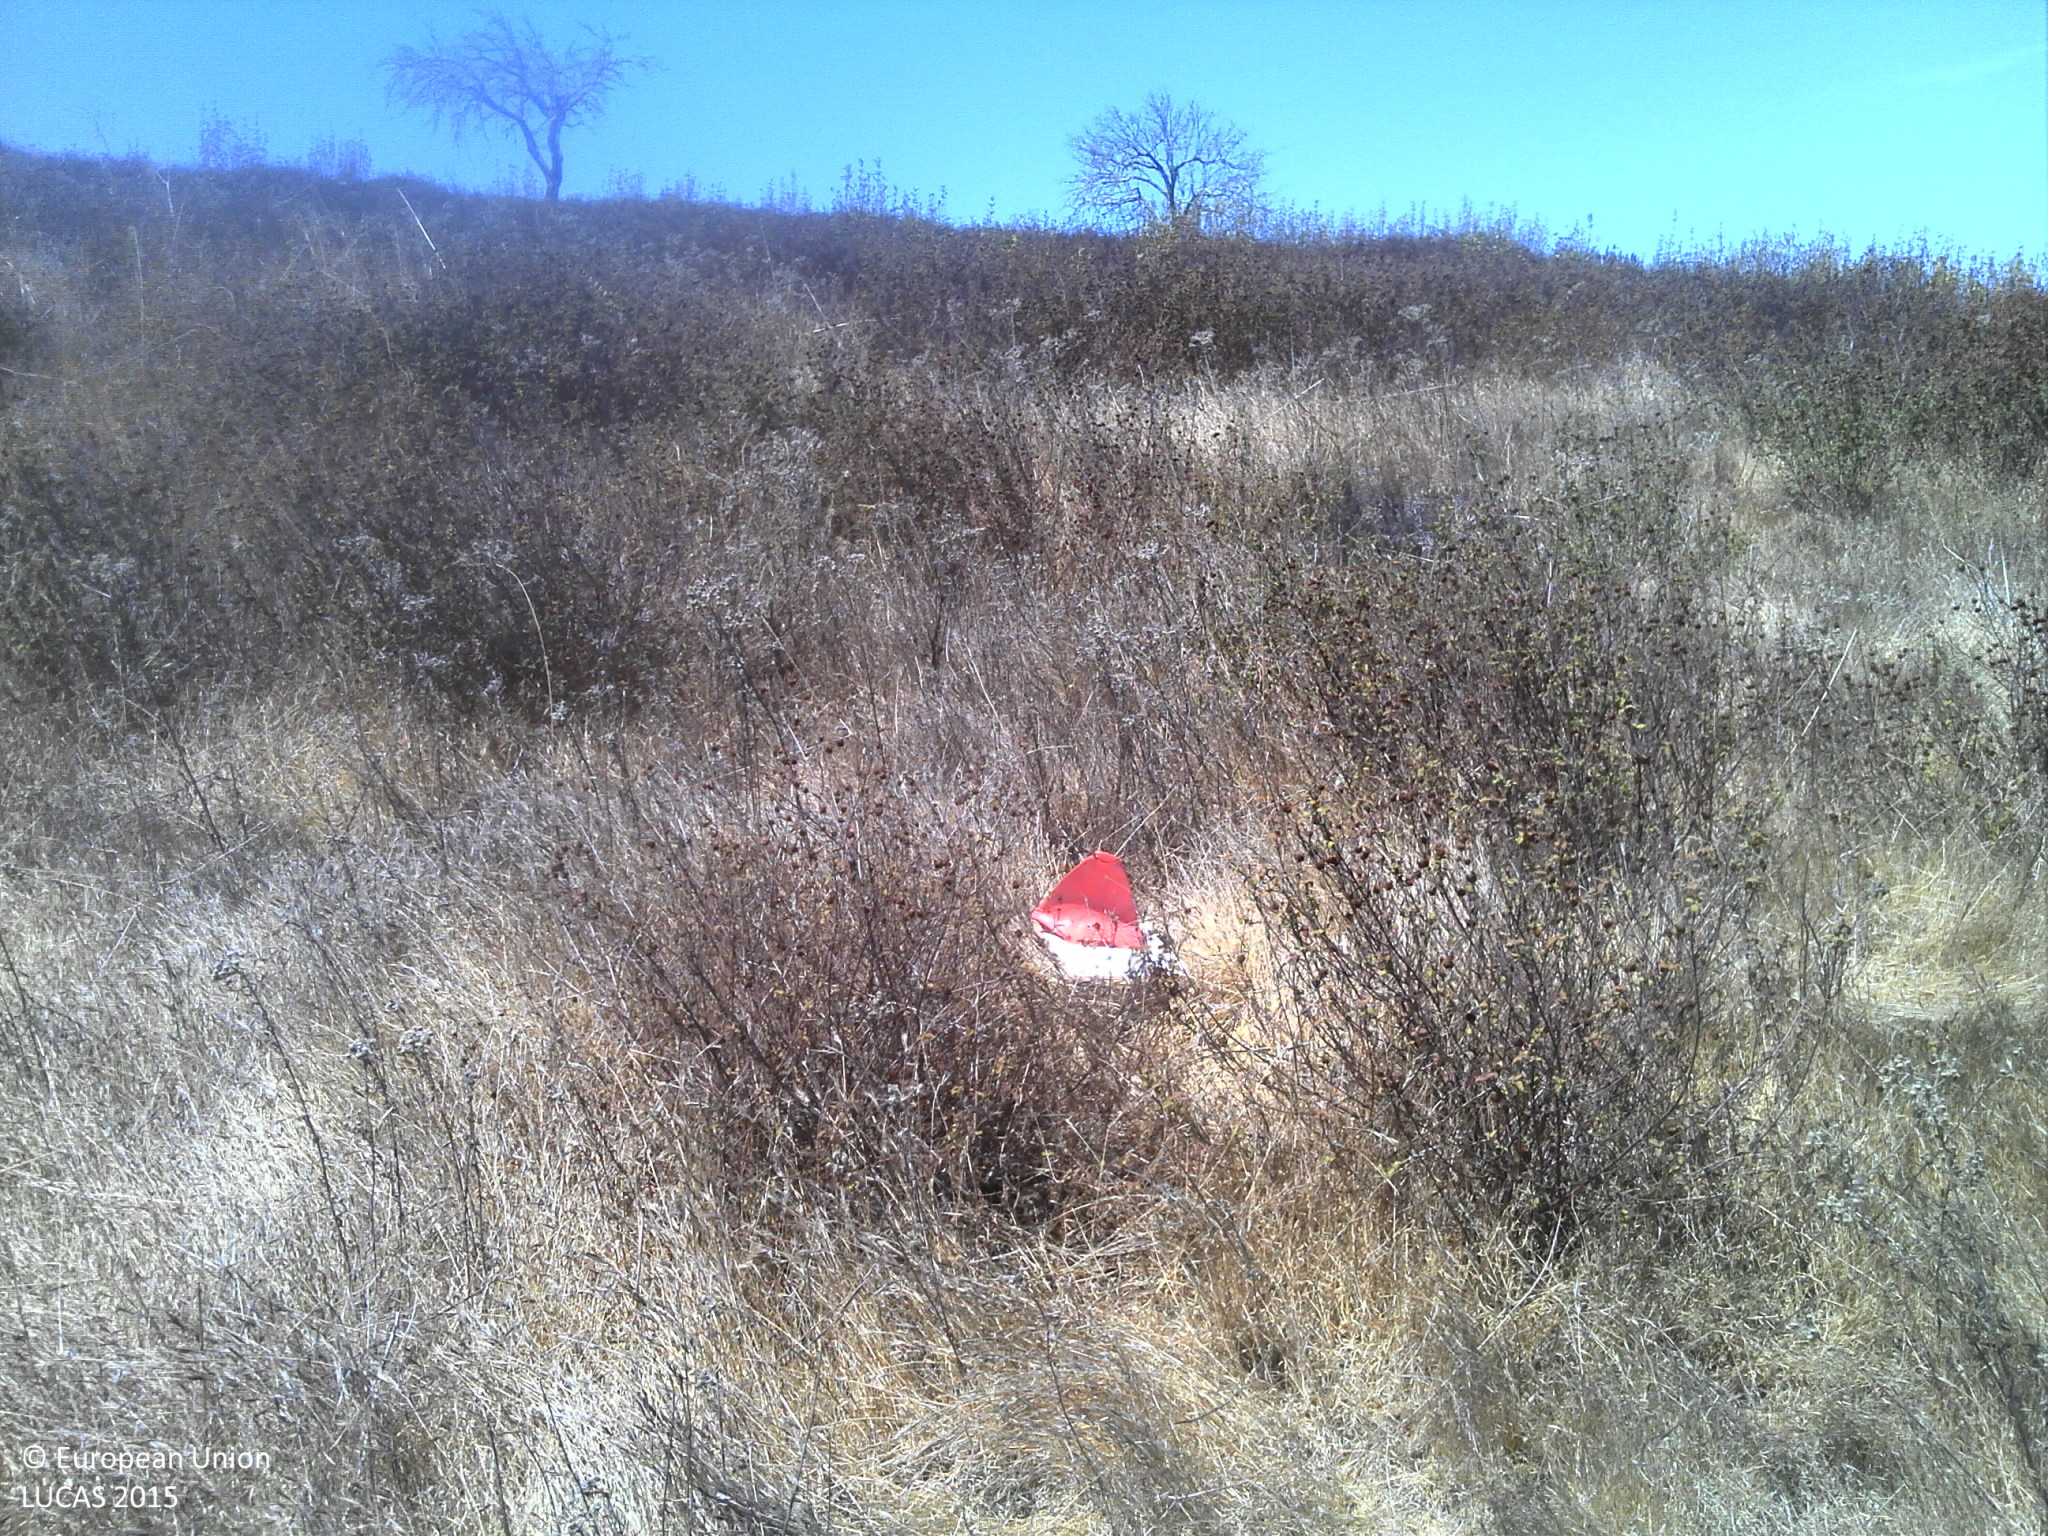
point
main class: Grassland
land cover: Grassland without tree/shrub cover
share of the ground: > 75 %
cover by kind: herbaceous plants 75 %, unconsolidated bare surface 25 %
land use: Agriculture (excluding fallow land and kitchen gardens)
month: August
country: PT
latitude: 37.5247
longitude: -8.2327
